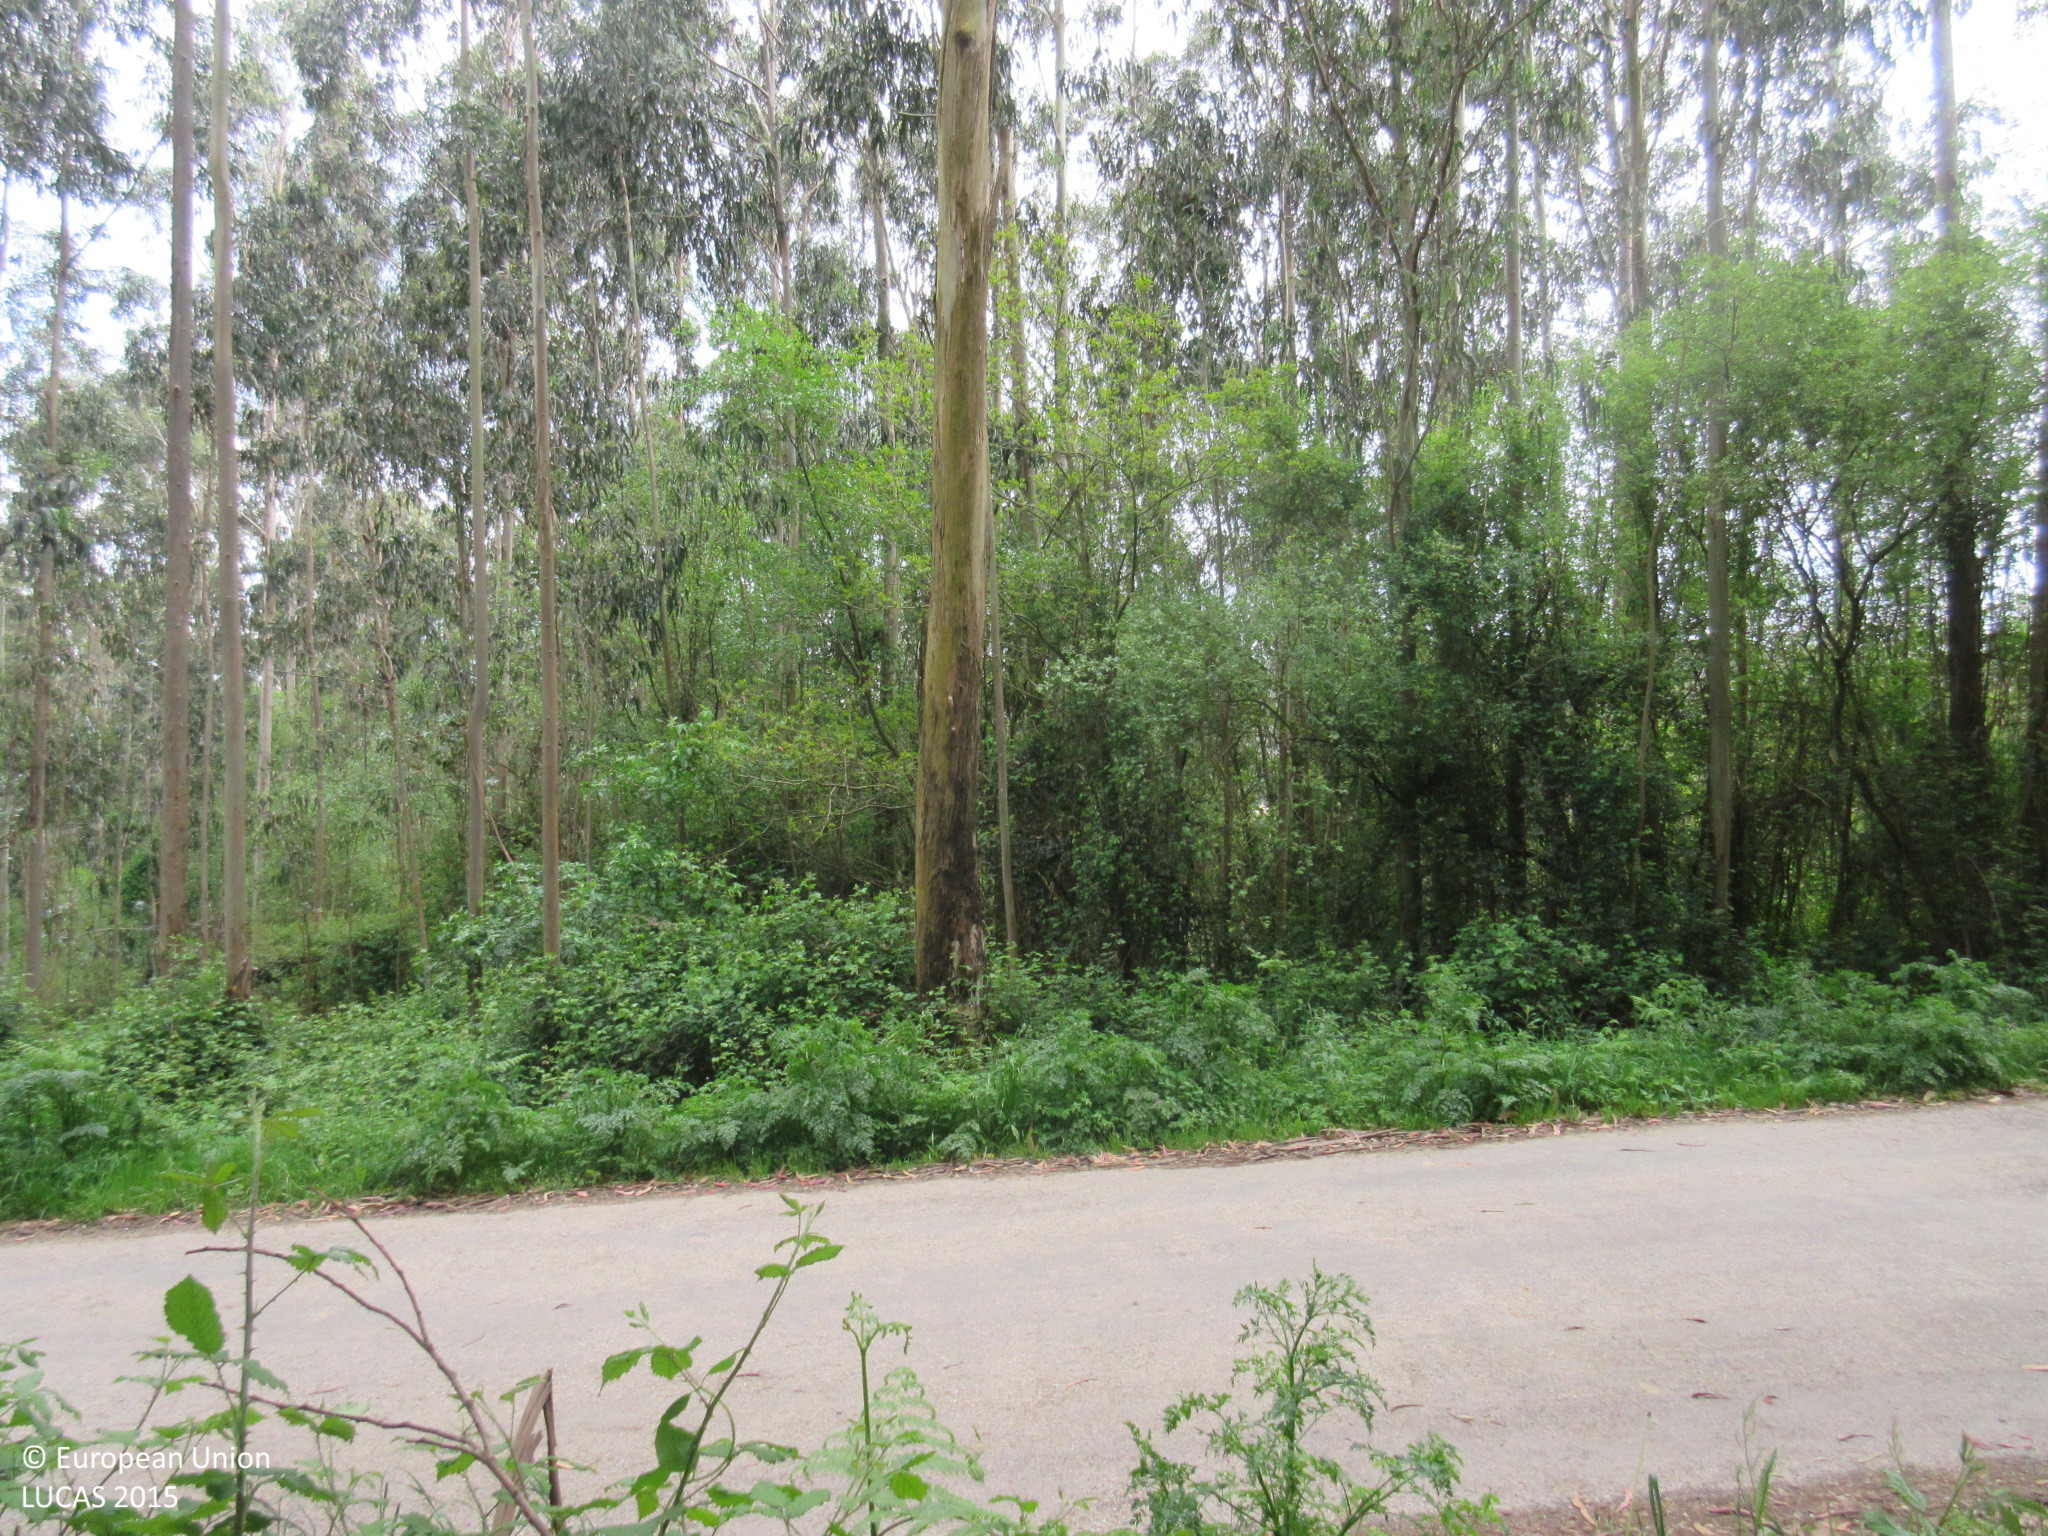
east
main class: Woodland
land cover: Broadleaved woodland
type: exotic forest
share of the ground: > 75 %
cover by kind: broadleaved forest trees 95 %, shrubs 5 %
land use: Forestry
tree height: > 5 m
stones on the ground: < 10 %
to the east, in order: Broadleaved woodland; Grass margins; Paved roads, cycling and walking lanes; Grass margins; Broadleaved woodland; Tracks; Broadleaved woodland; Tracks; Abandoned hedges; Grassland without tree/shrub cover
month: April
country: ES
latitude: 43.4852
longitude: -7.1216
